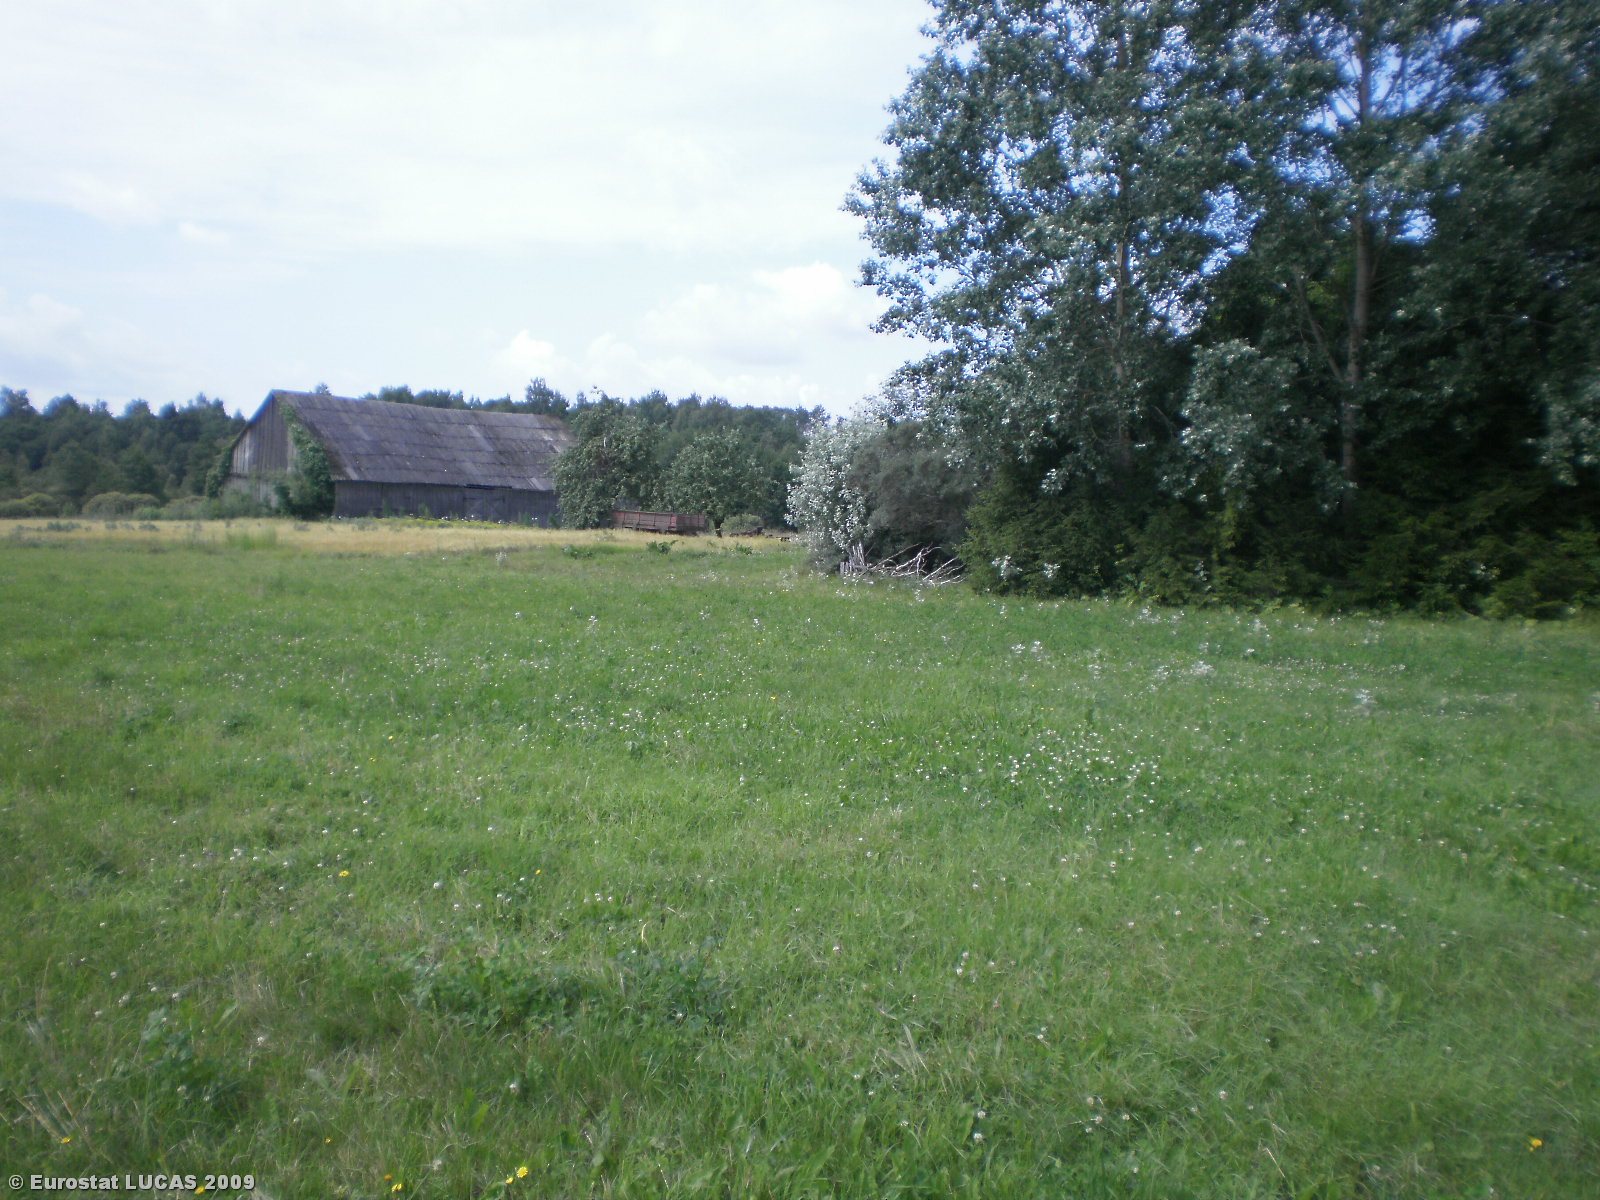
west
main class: Grassland
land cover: Grassland without tree/shrub cover
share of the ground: > 75 %
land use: Agriculture (excluding fallow land and kitchen gardens)
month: July
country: LT
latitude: 56.0322
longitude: 25.1505
